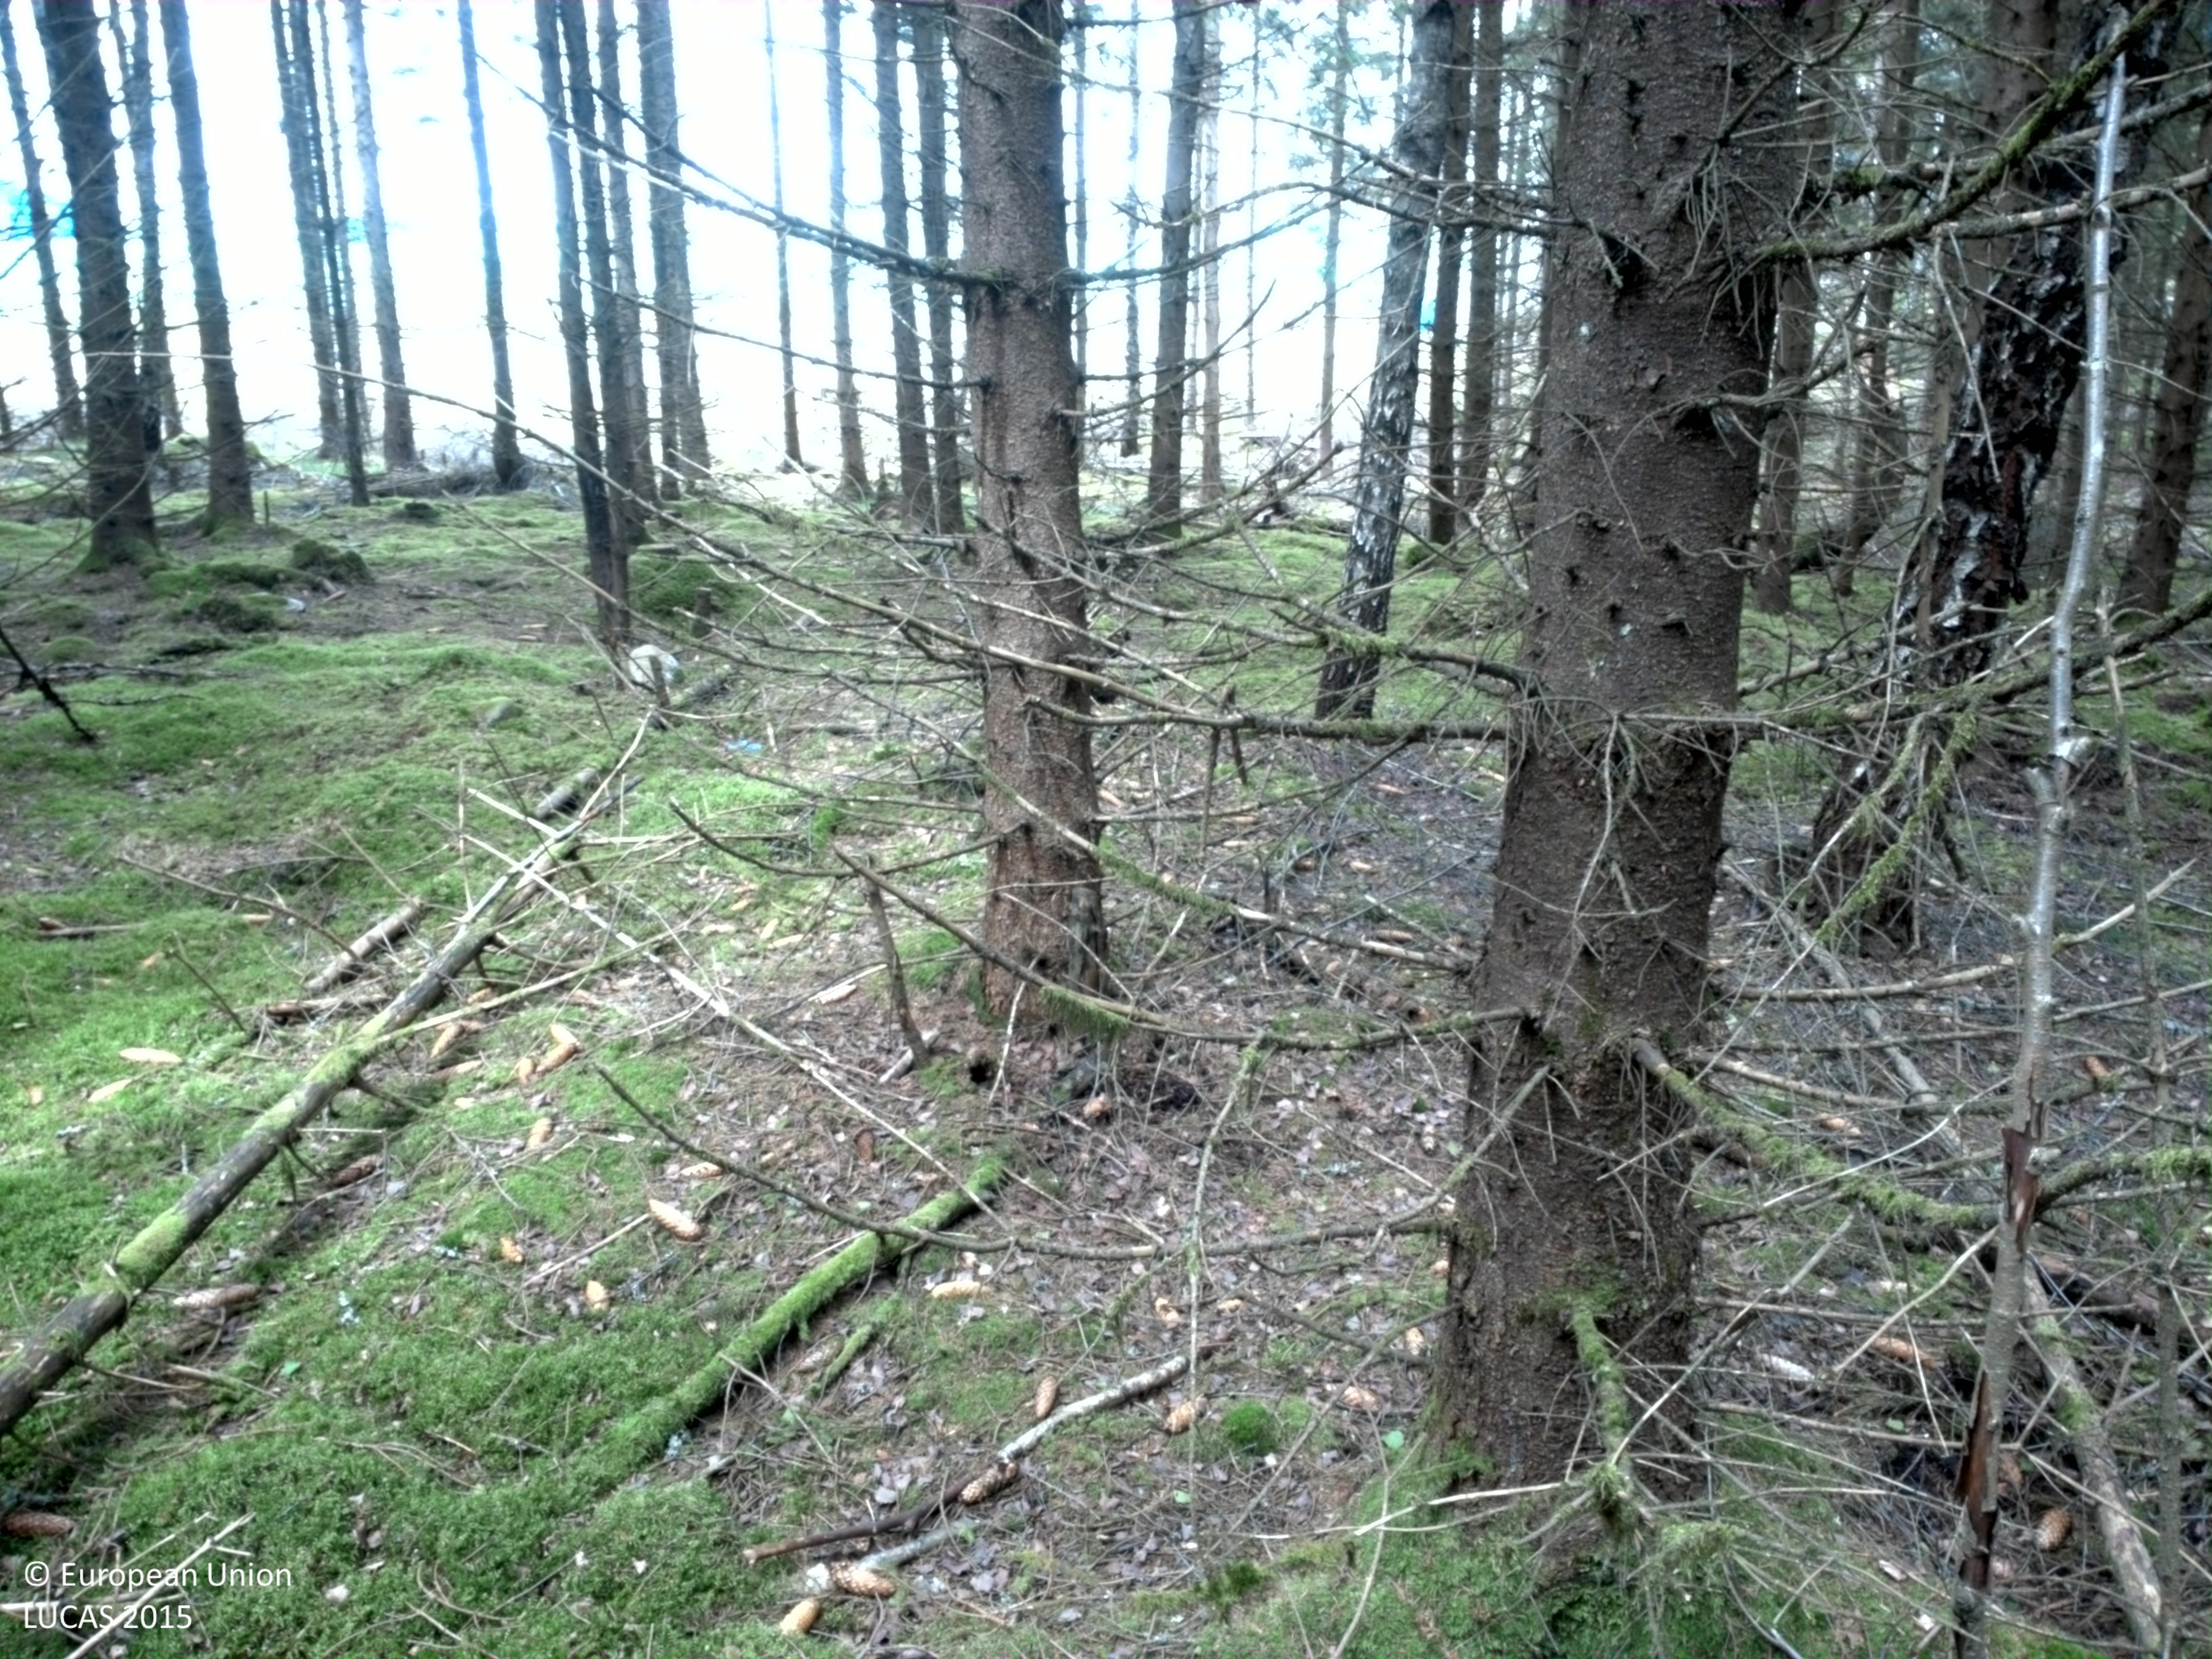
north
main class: Woodland
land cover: Spruce dominated coniferous woodland
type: boreal forest
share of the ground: > 75 %
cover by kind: coniferous forest trees 85 %, lichens and mosses 15 %
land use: Forestry
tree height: > 5 m
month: May
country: SE
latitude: 56.5587
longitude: 15.4494
